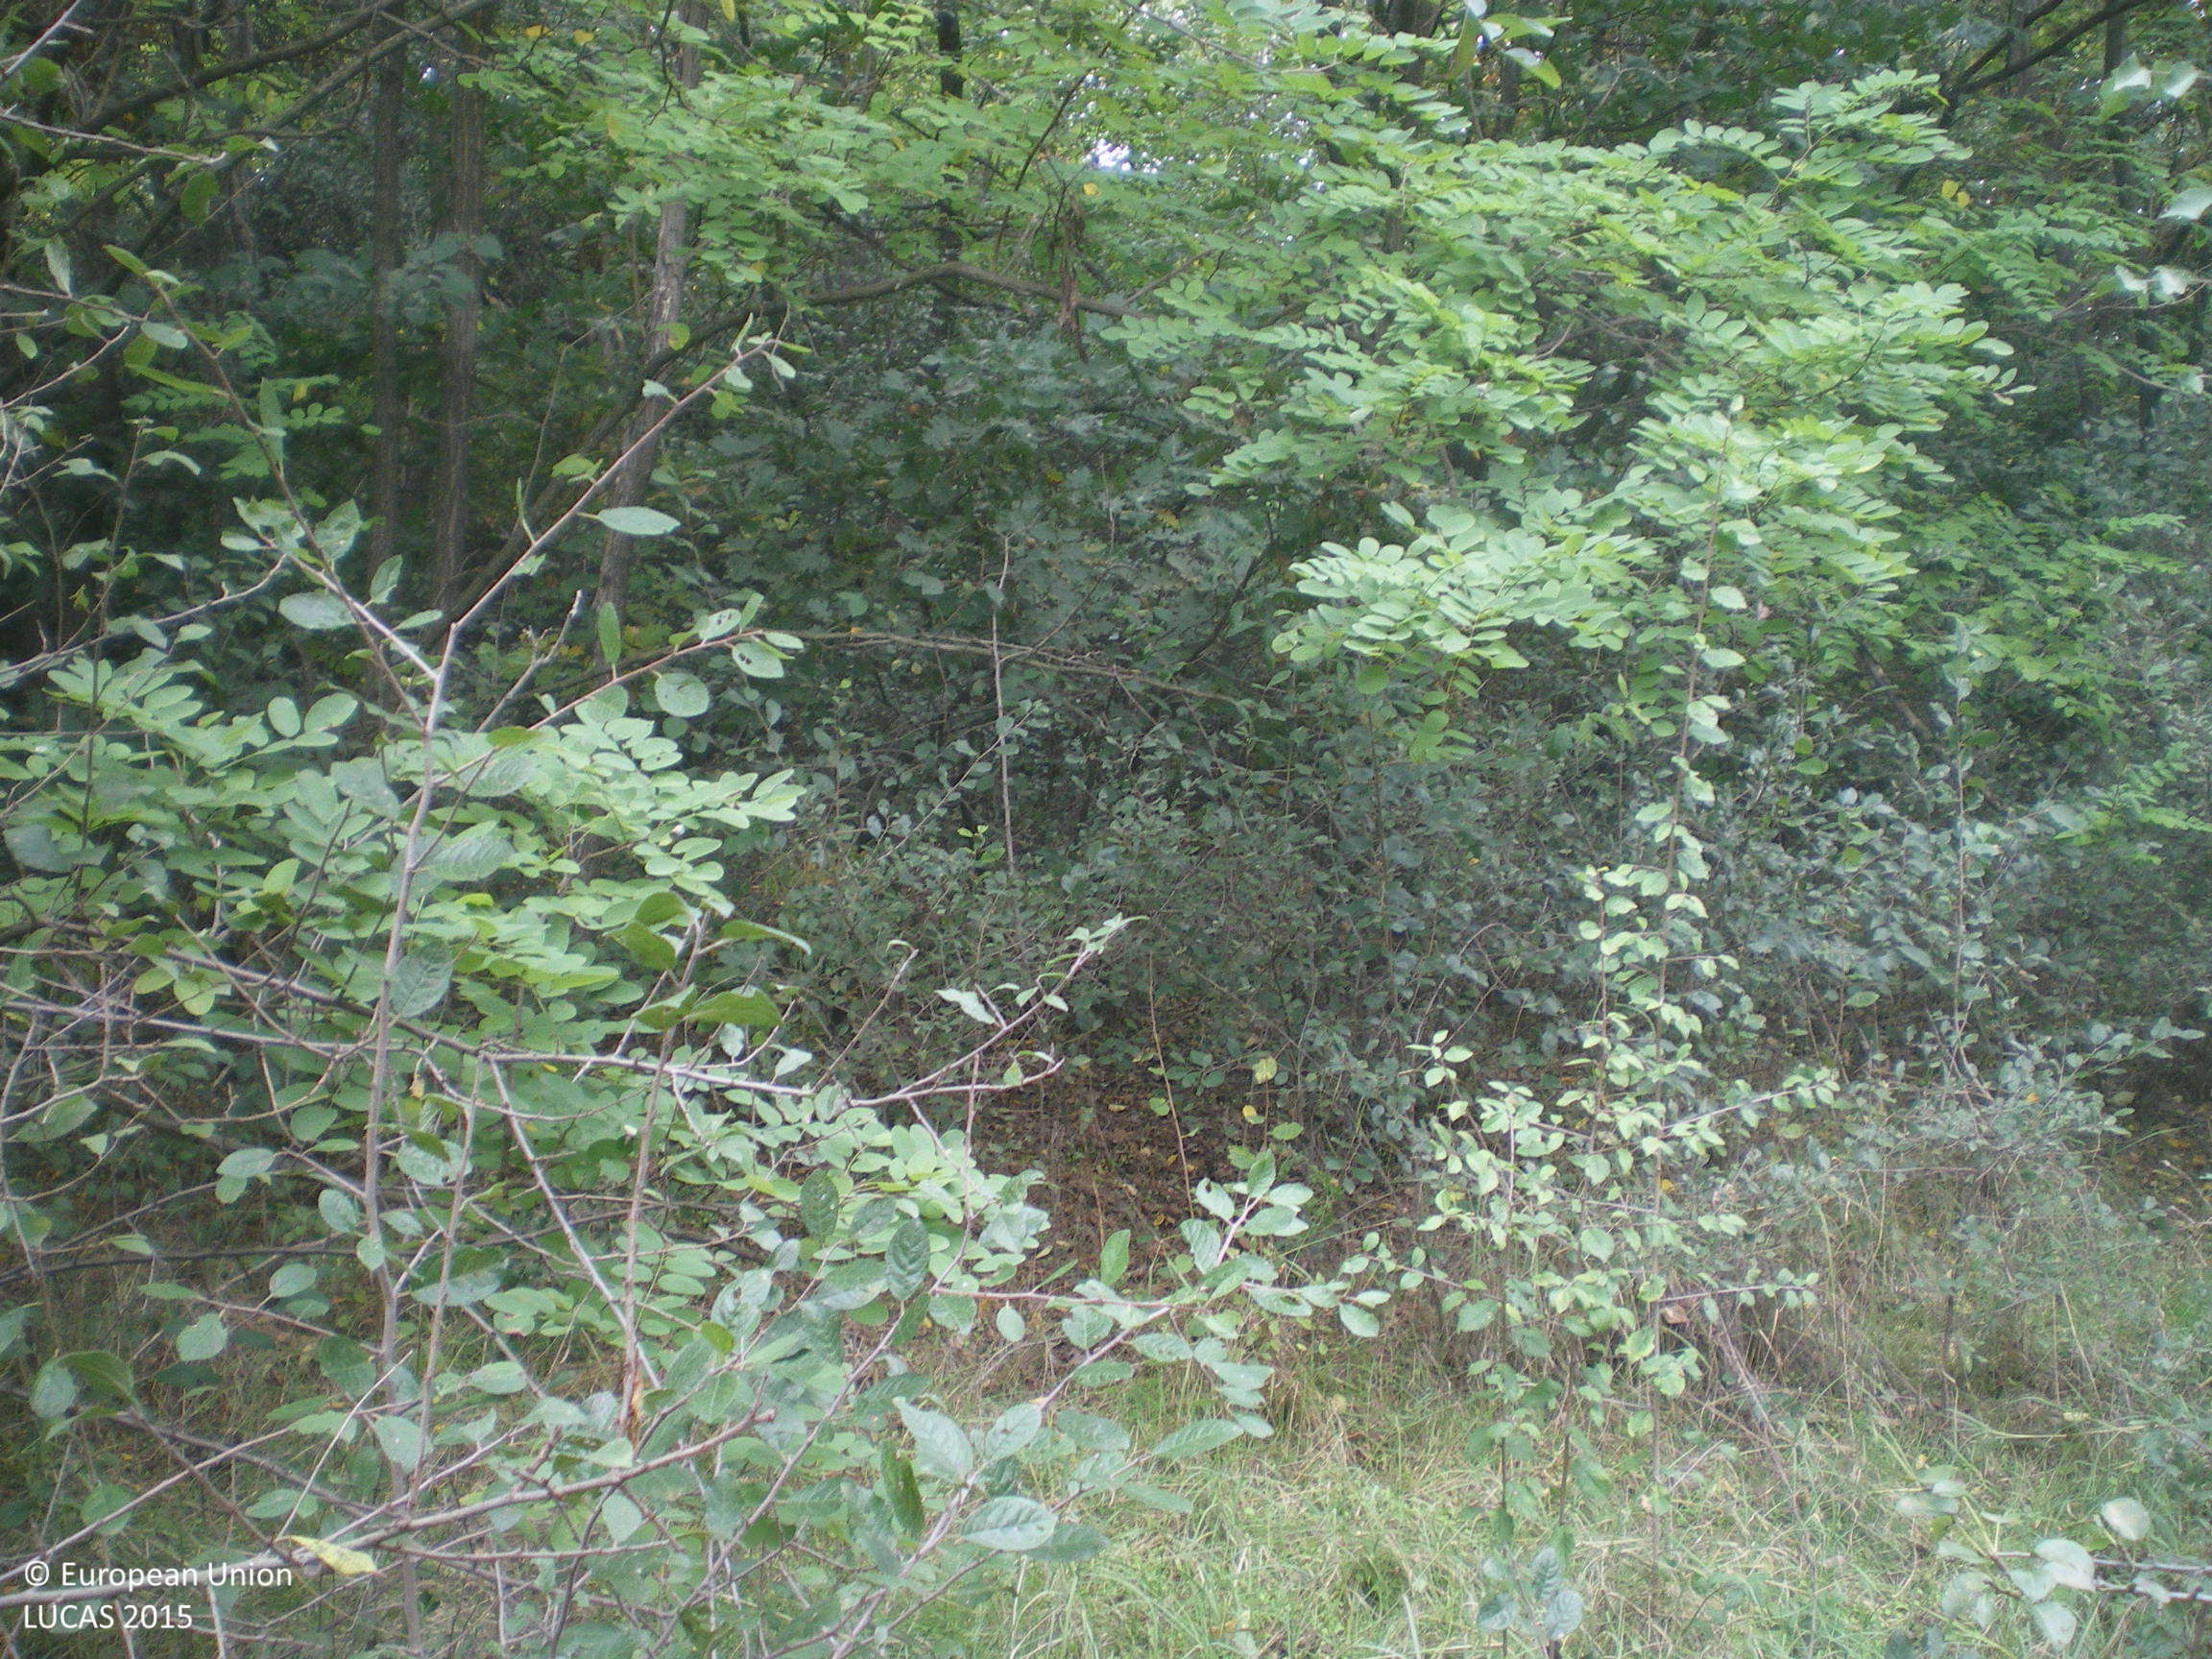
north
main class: Woodland
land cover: Broadleaved woodland
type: mesophytic deciduous forest
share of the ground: > 75 %
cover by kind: broadleaved forest trees 95 %, unconsolidated bare surface 5 %
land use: Forestry
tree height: > 5 m
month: October
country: BG
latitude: 42.0531
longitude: 25.7657
